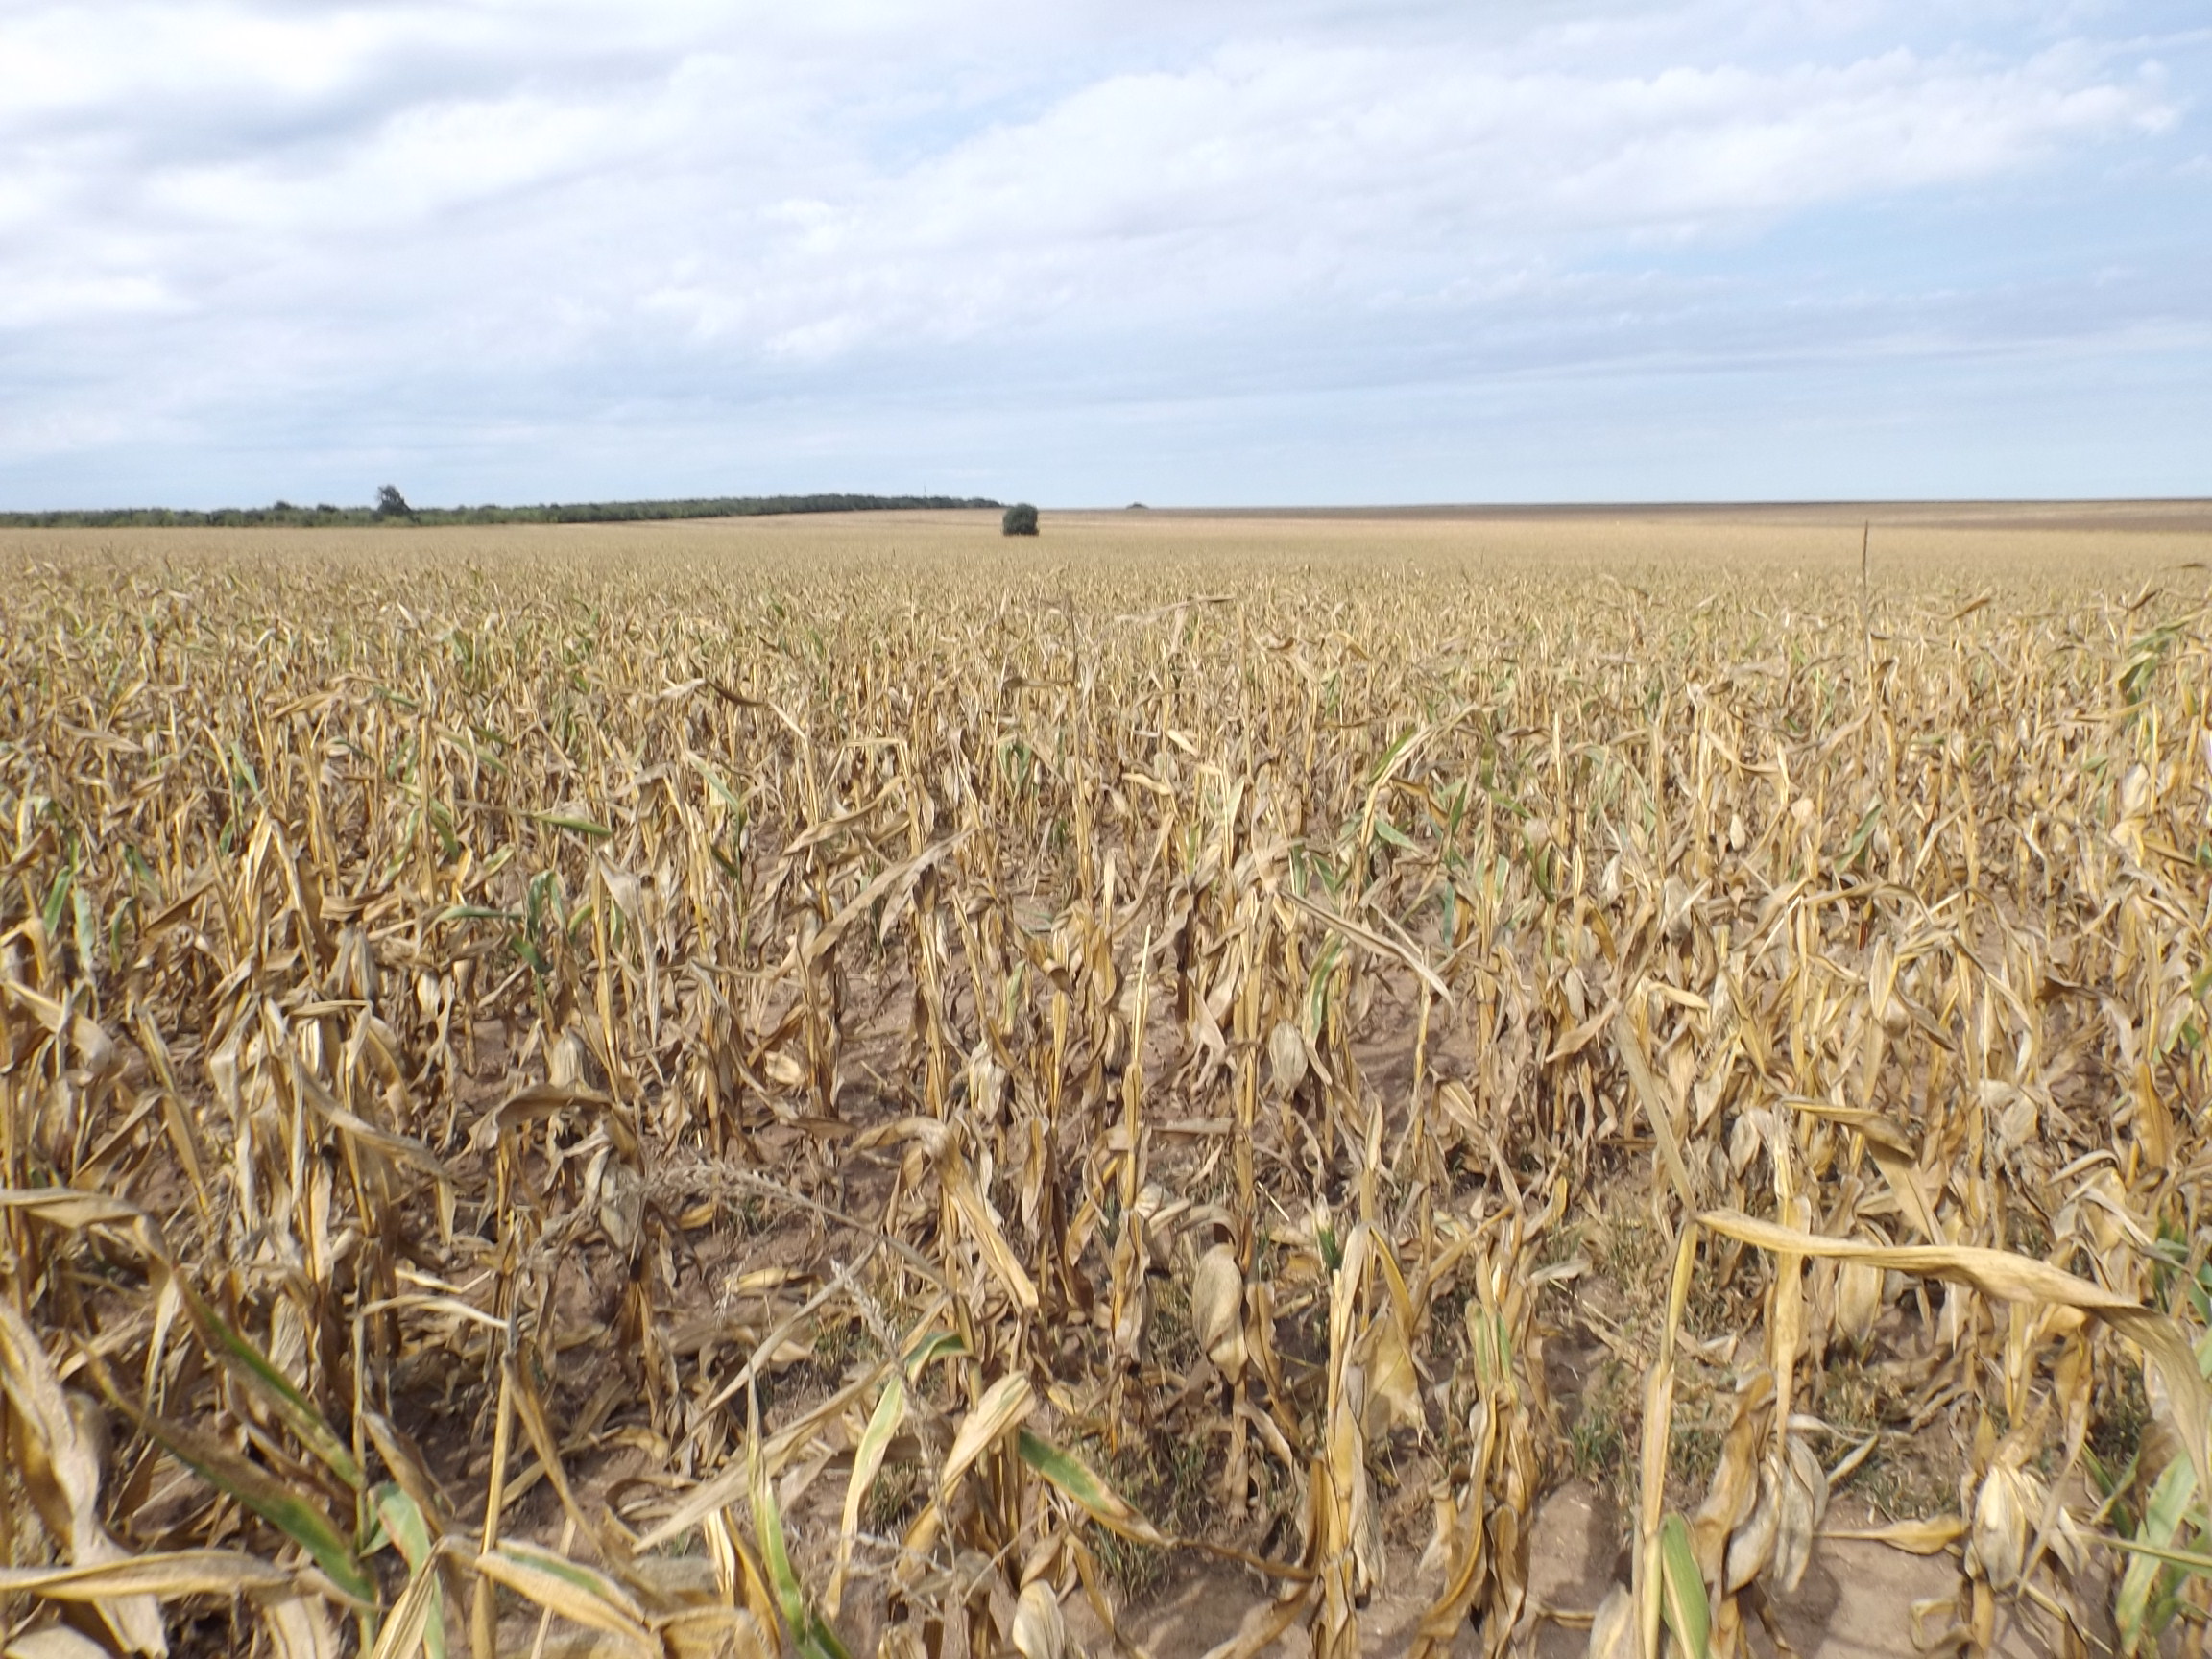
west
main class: Cropland
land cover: Maize
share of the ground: > 75 %
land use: Agriculture (excluding fallow land and kitchen gardens)
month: September
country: BG
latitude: 43.3873
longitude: 27.3714
